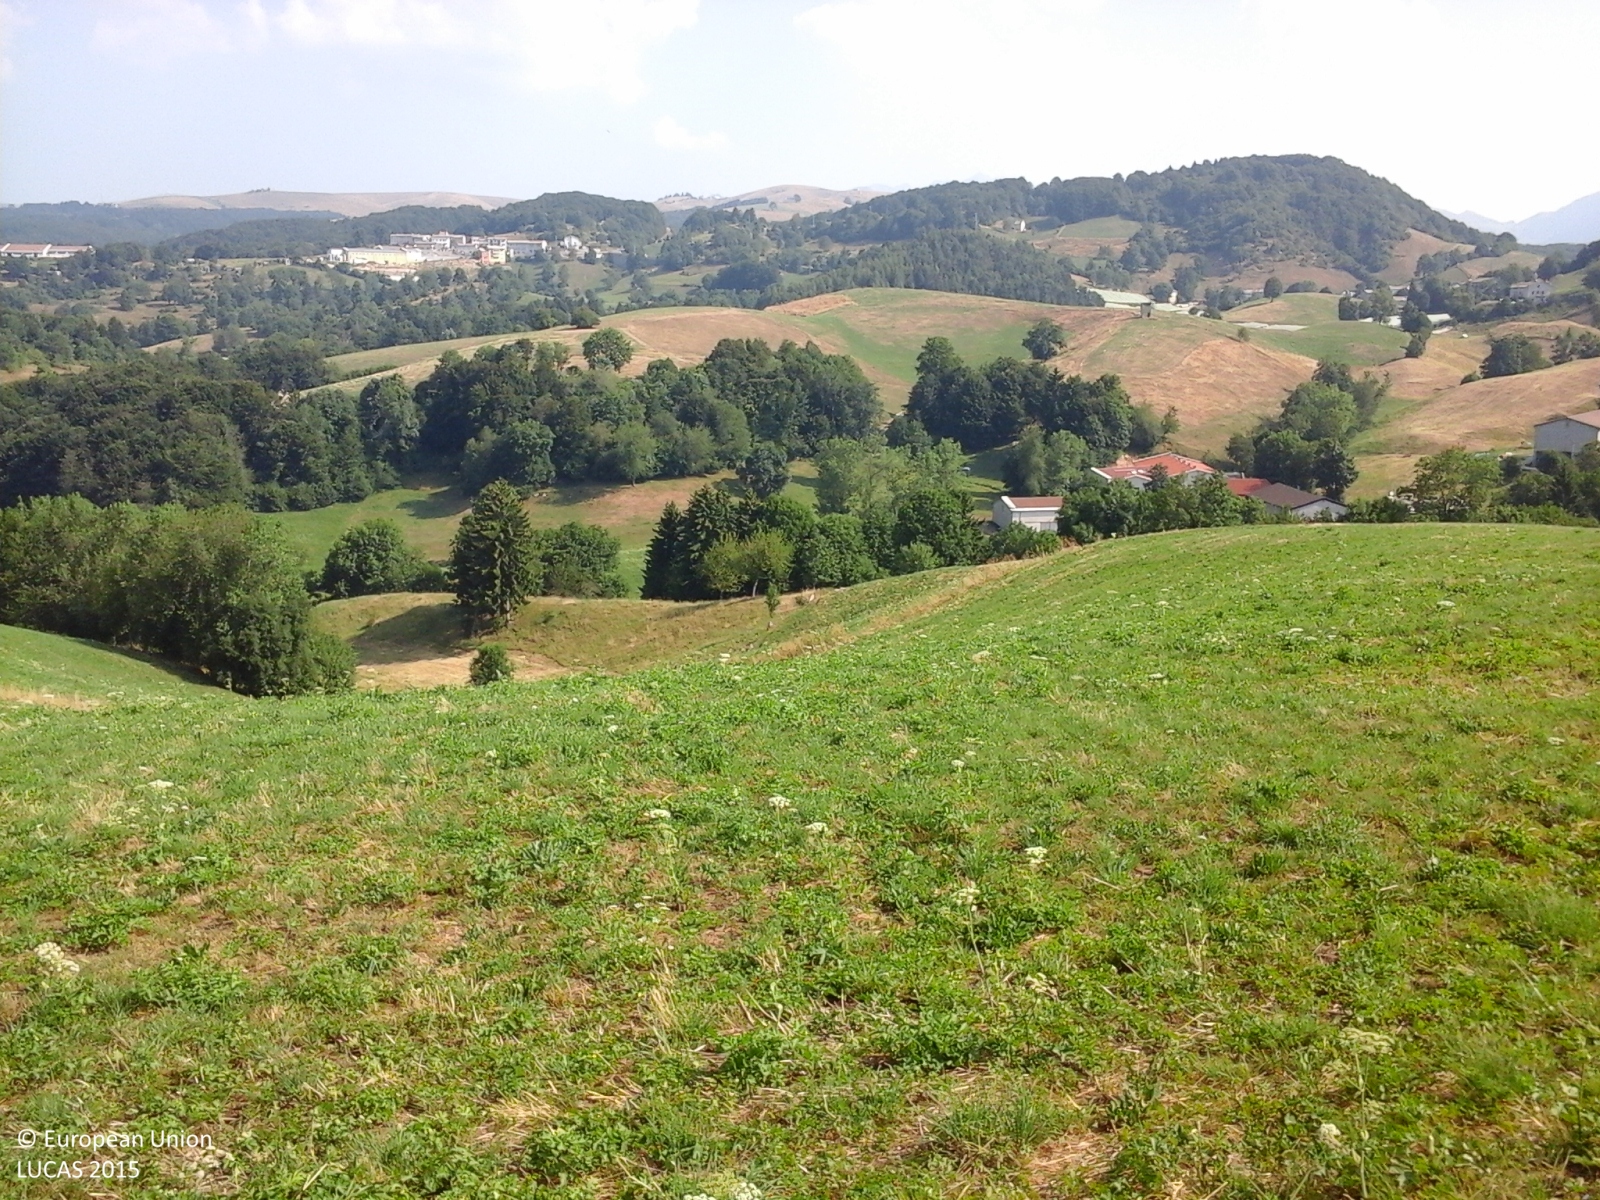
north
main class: Grassland
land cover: Grassland without tree/shrub cover
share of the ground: > 75 %
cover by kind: herbaceous plants 100 %
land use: Agriculture (excluding fallow land and kitchen gardens)
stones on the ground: < 10 %
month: July
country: IT
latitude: 45.6069
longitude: 11.0881
